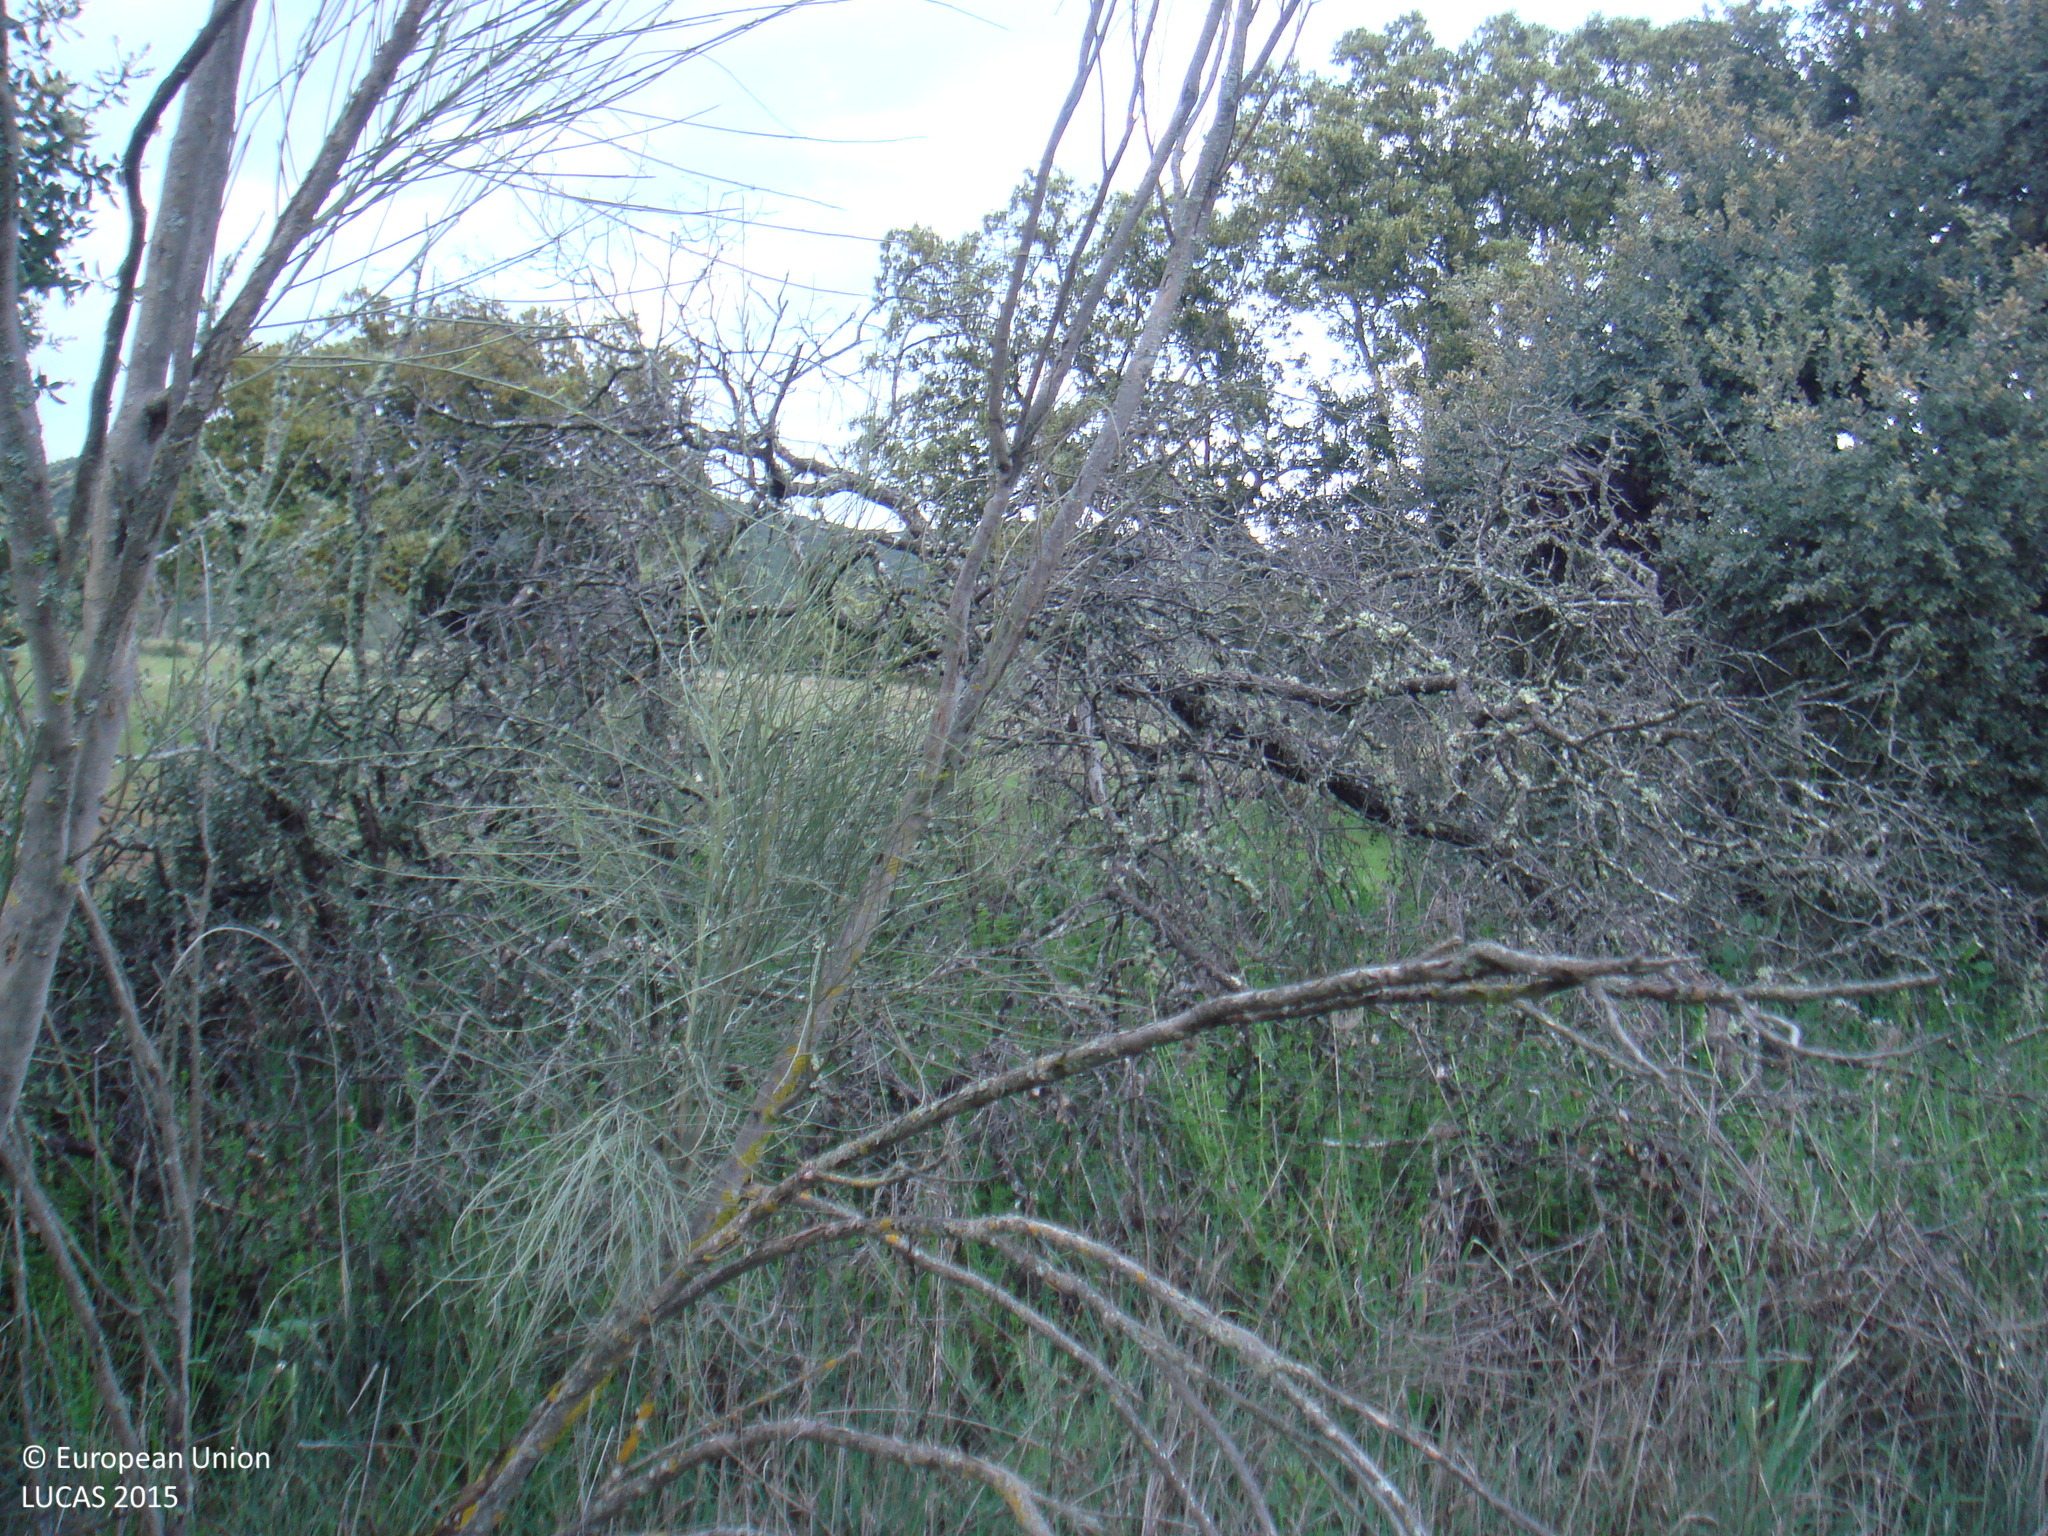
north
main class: Shrubland
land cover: Shrubland with sparse tree cover
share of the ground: 50 - 75 %
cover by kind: shrubs 55 %, herbaceous plants 40 %, broadleaved forest trees 5 %
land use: Semi-natural and natural areas not in use
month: April
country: ES
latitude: 38.2316
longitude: -5.3017
